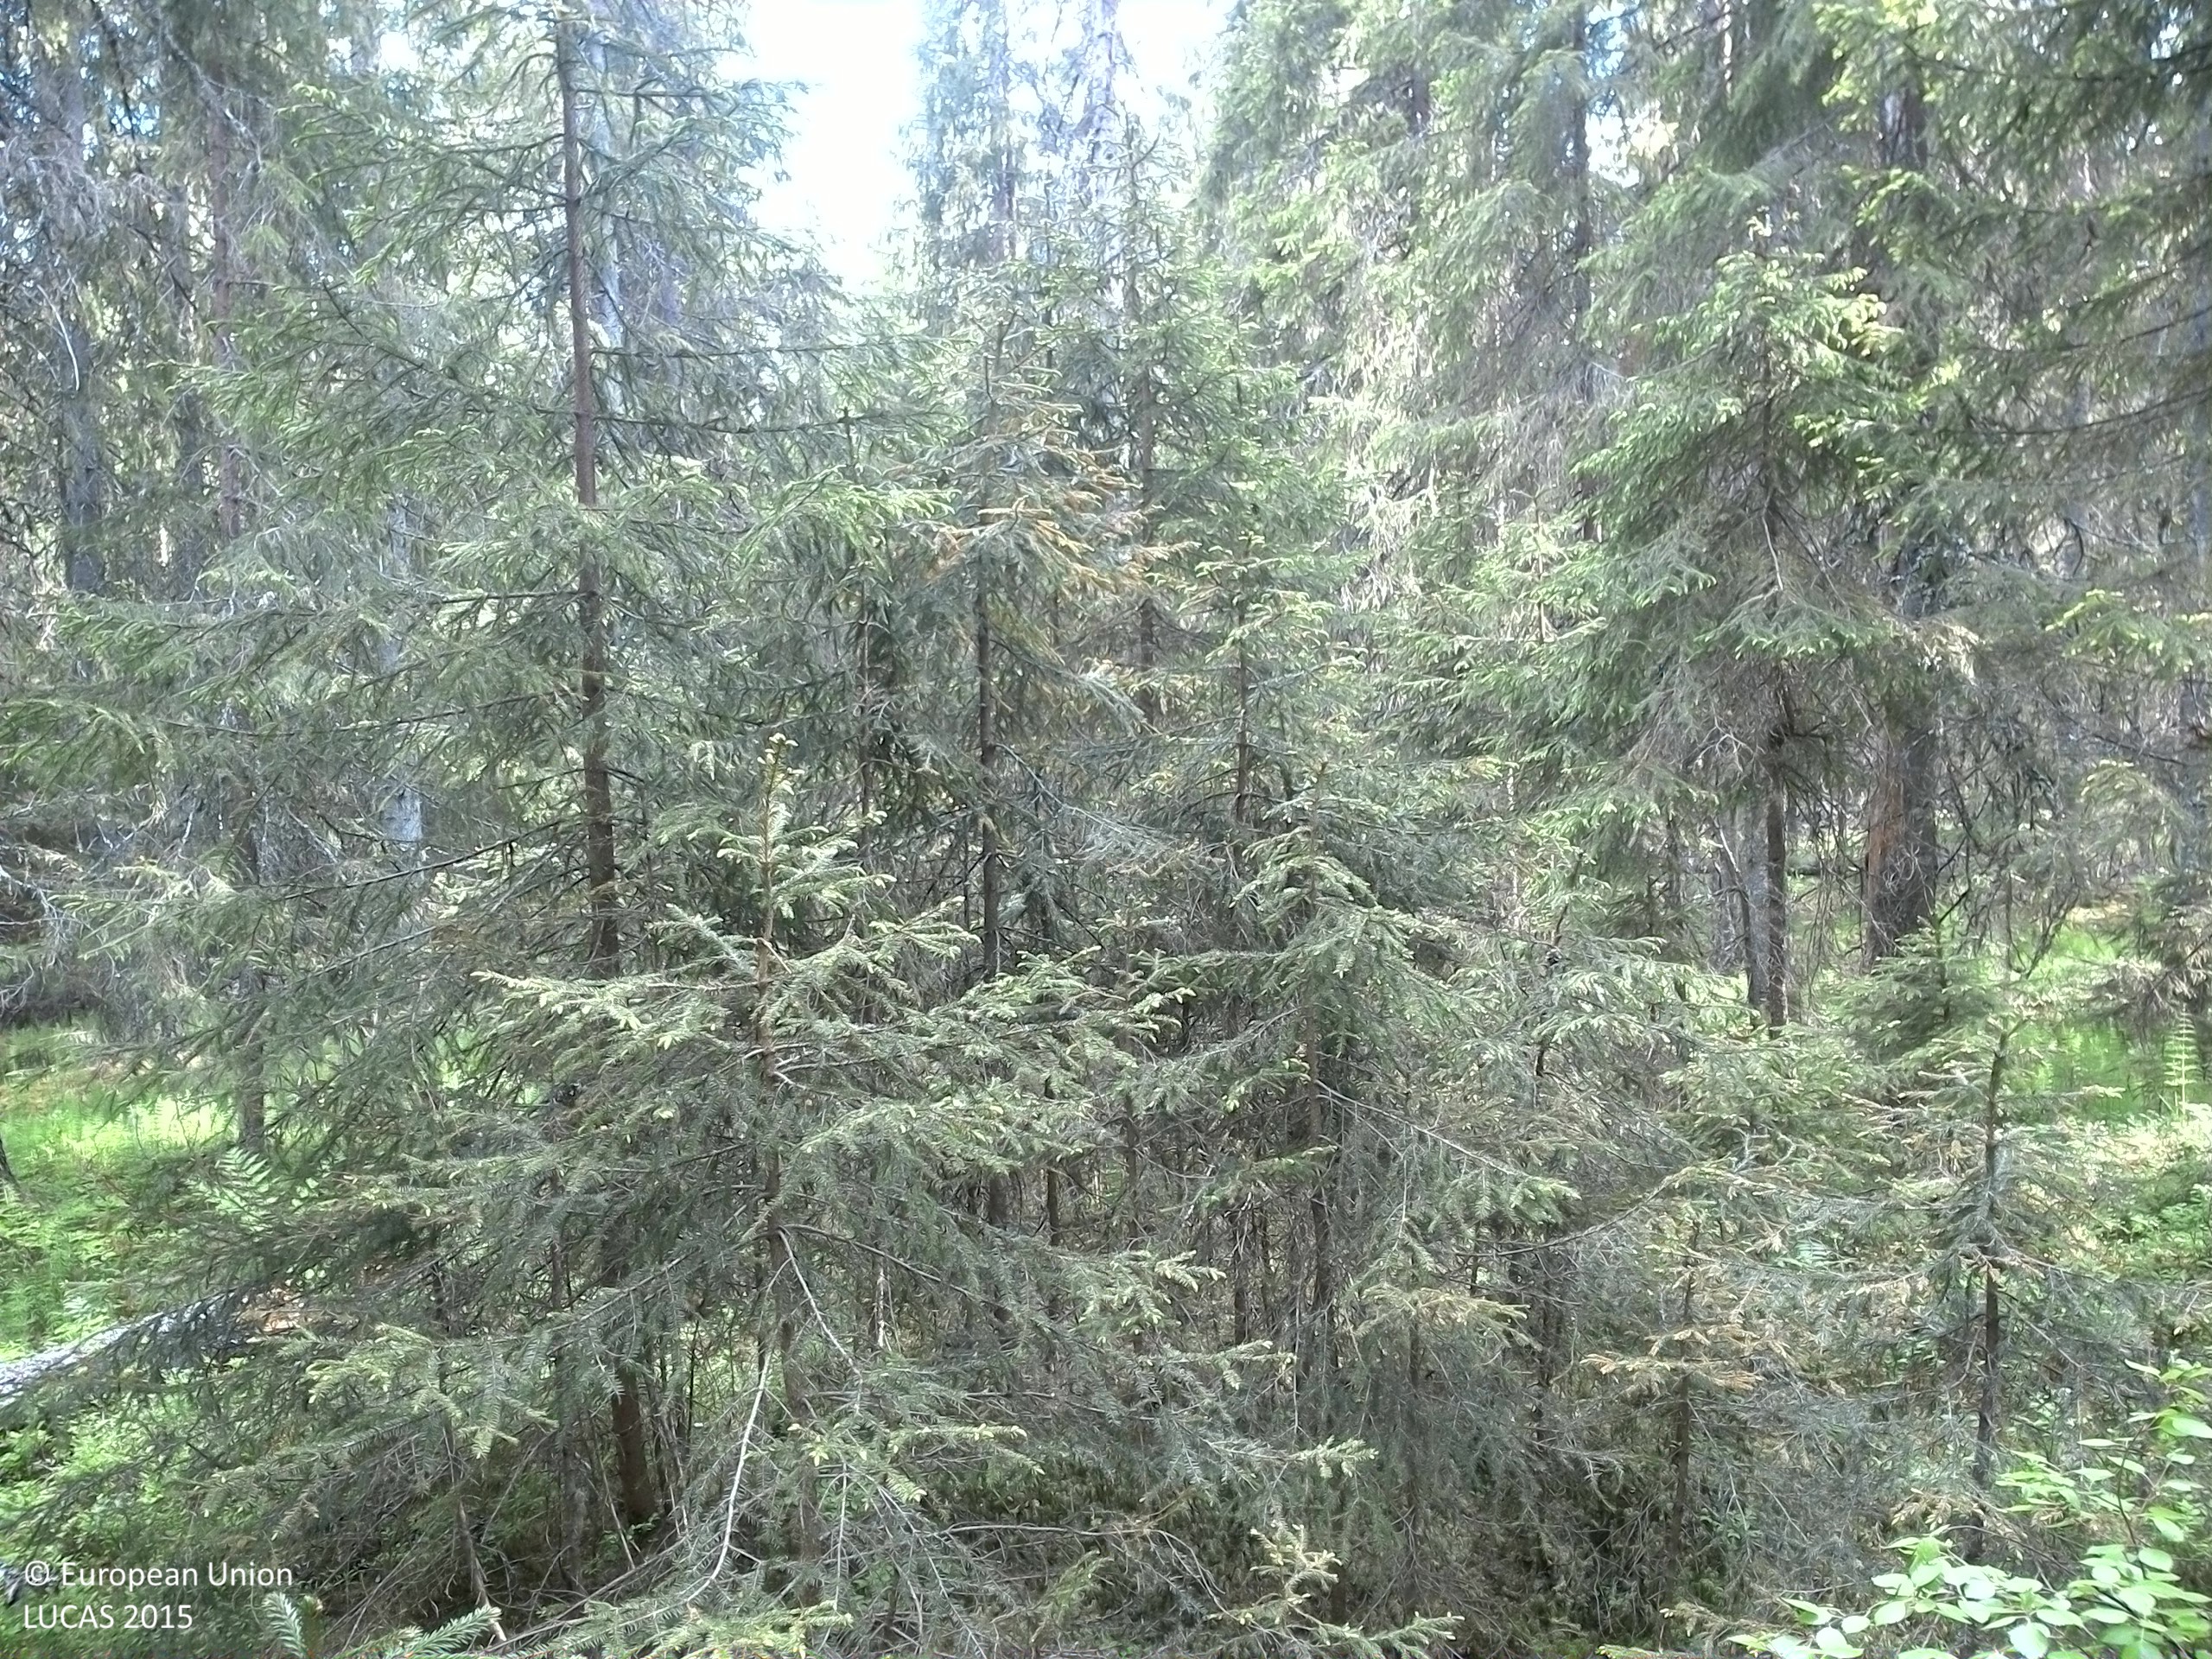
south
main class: Woodland
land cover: Spruce dominated coniferous woodland
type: boreal forest
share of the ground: 50 - 75 %
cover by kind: coniferous forest trees 60 %, shrubs 30 %, broadleaved forest trees 10 %
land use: Forestry
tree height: > 5 m
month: June
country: SE
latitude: 63.3910
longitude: 18.1205
